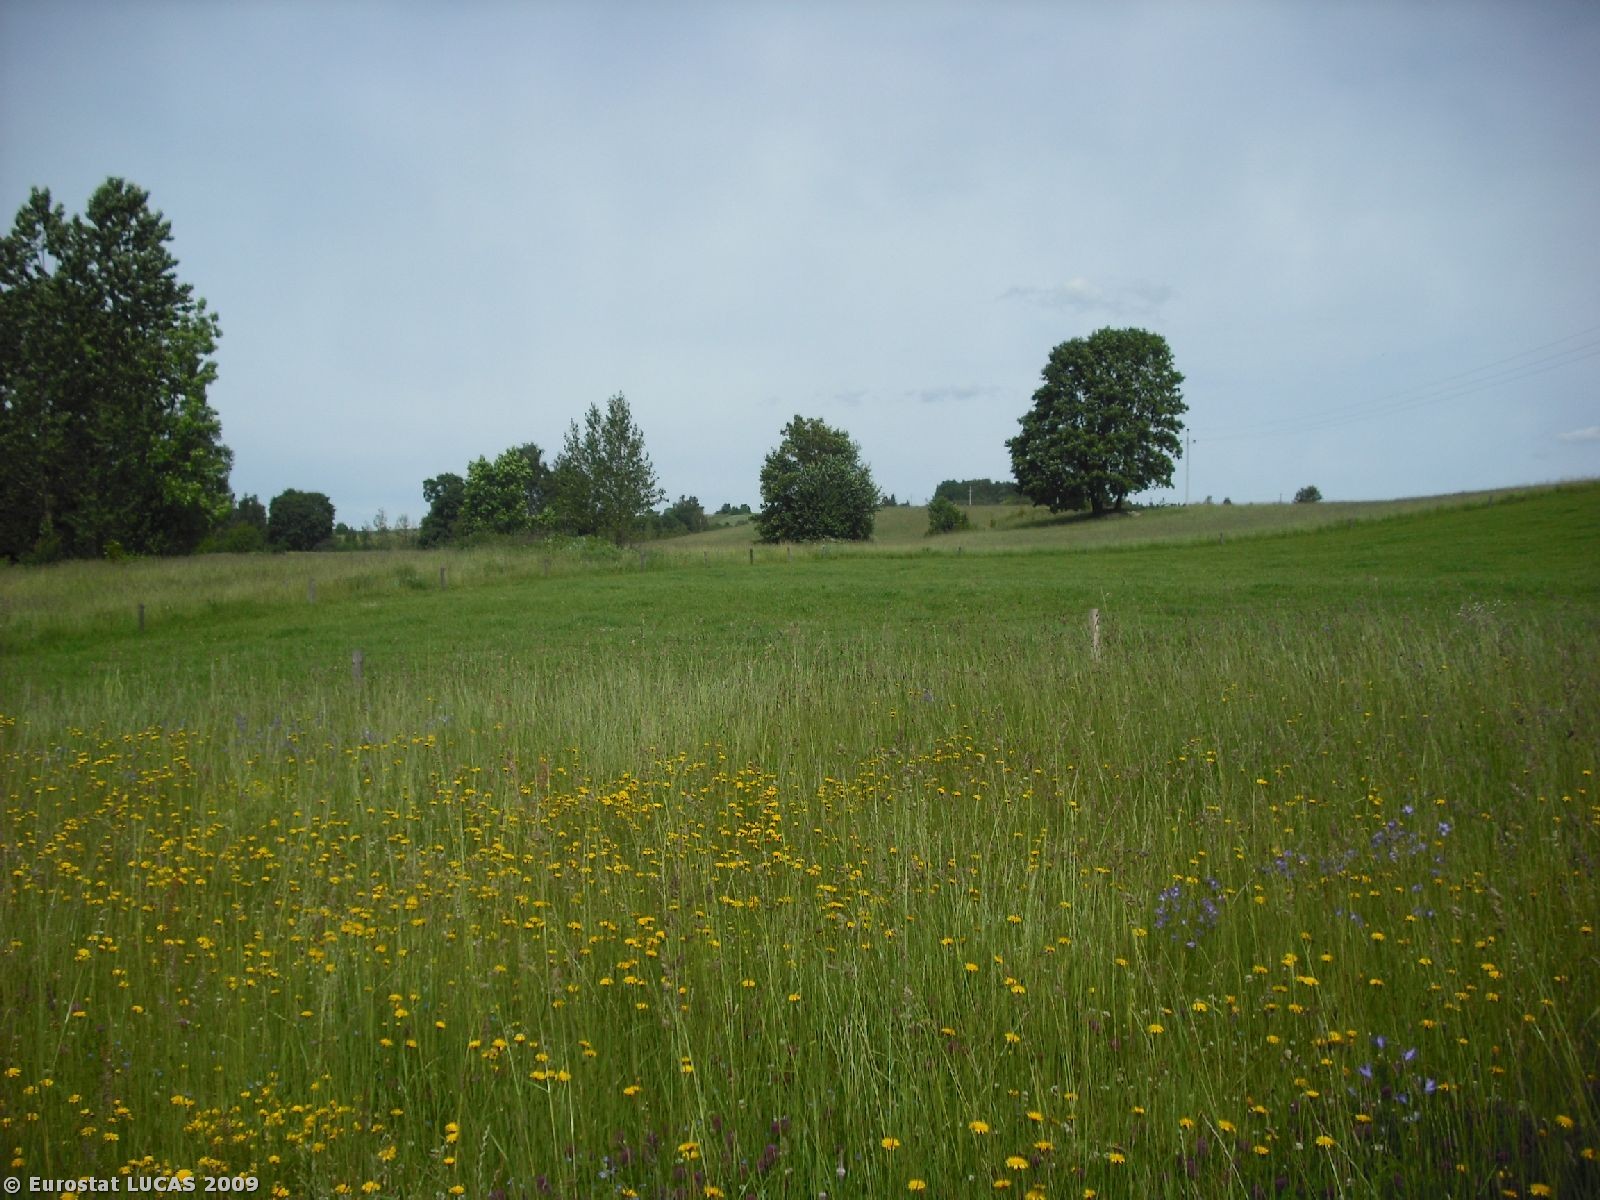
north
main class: Grassland
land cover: Grassland without tree/shrub cover
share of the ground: > 75 %
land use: Agriculture (excluding fallow land and kitchen gardens)
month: June
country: PL
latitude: 54.2967
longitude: 22.8698
